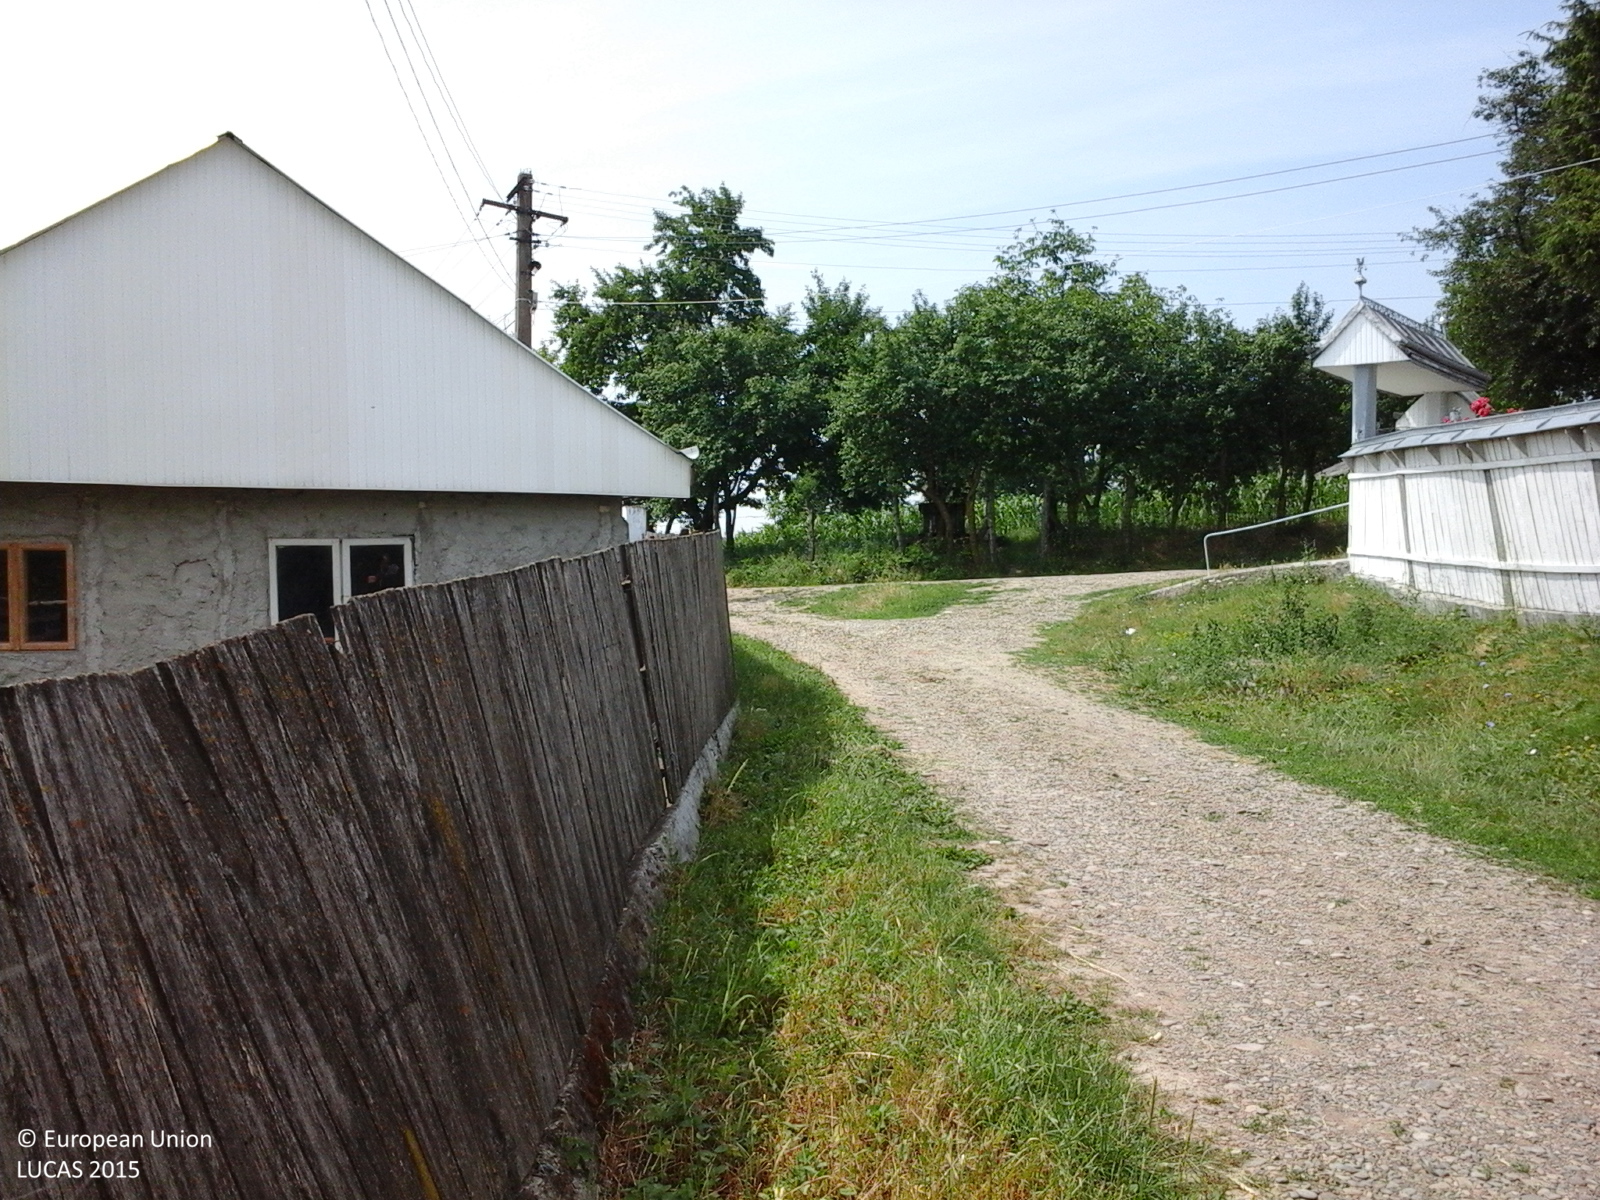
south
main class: Cropland
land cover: Other root crops
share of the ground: > 75 %
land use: Kitchen garden
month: June
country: RO
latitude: 47.3936
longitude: 26.7213
